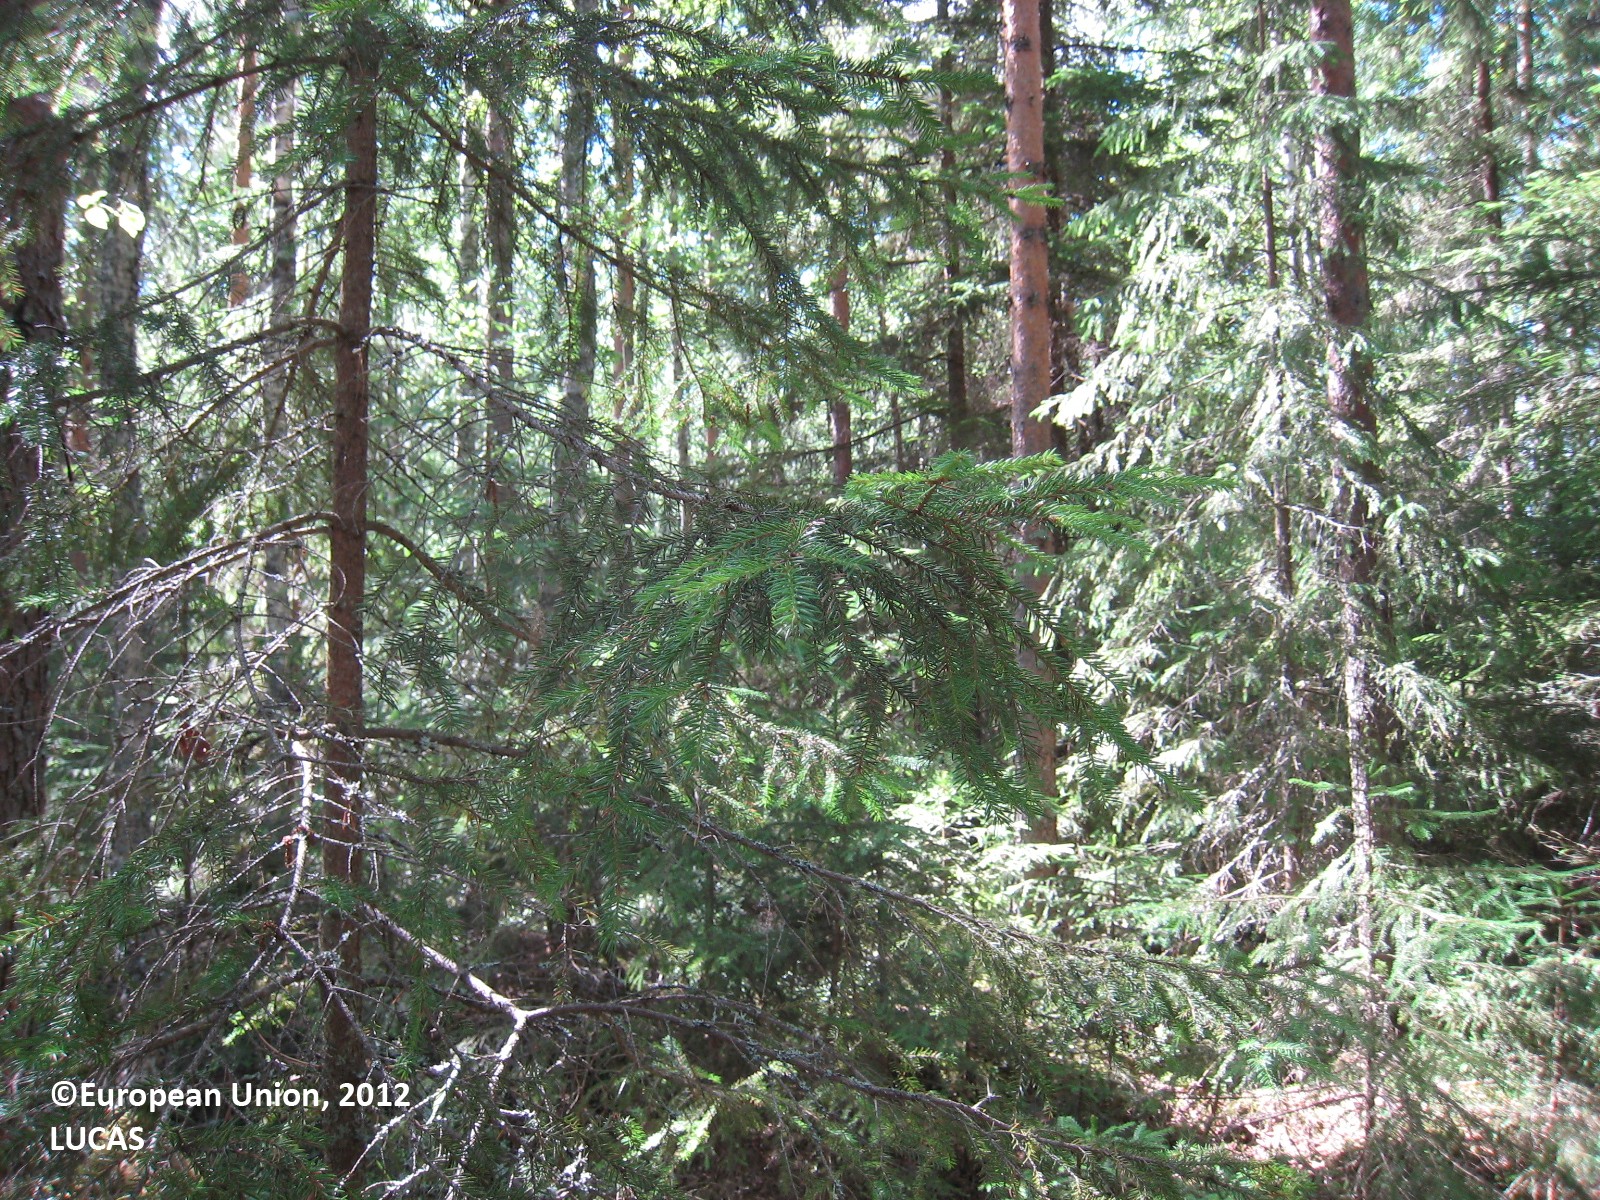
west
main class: Woodland
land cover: Other mixed woodland
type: boreal forest
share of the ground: > 75 %
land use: Forestry
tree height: > 5 m
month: July
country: FI
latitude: 63.0395
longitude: 25.6697
